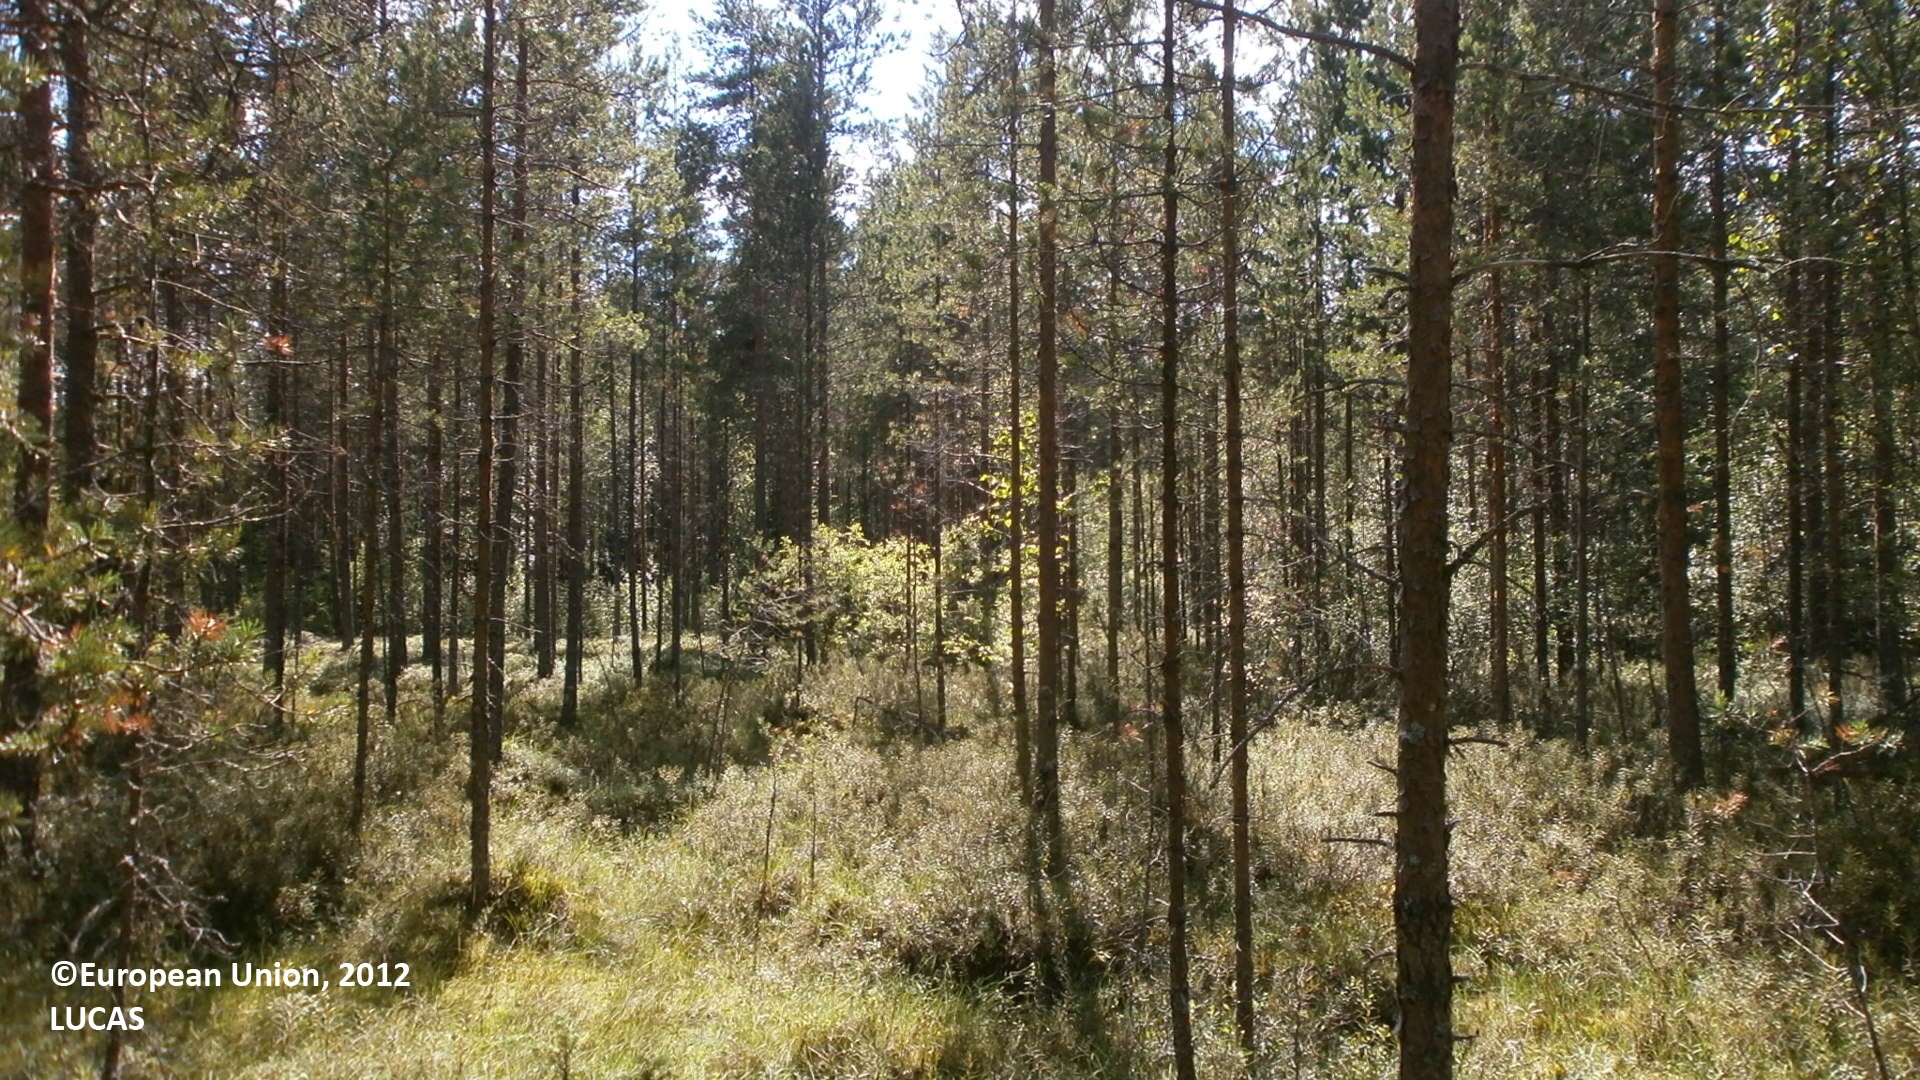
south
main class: Woodland
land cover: Pine dominated coniferous woodland
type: mire and swamp forests
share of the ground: 50 - 75 %
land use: Forestry
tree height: > 5 m
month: July
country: FI
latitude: 64.1462
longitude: 24.3548
